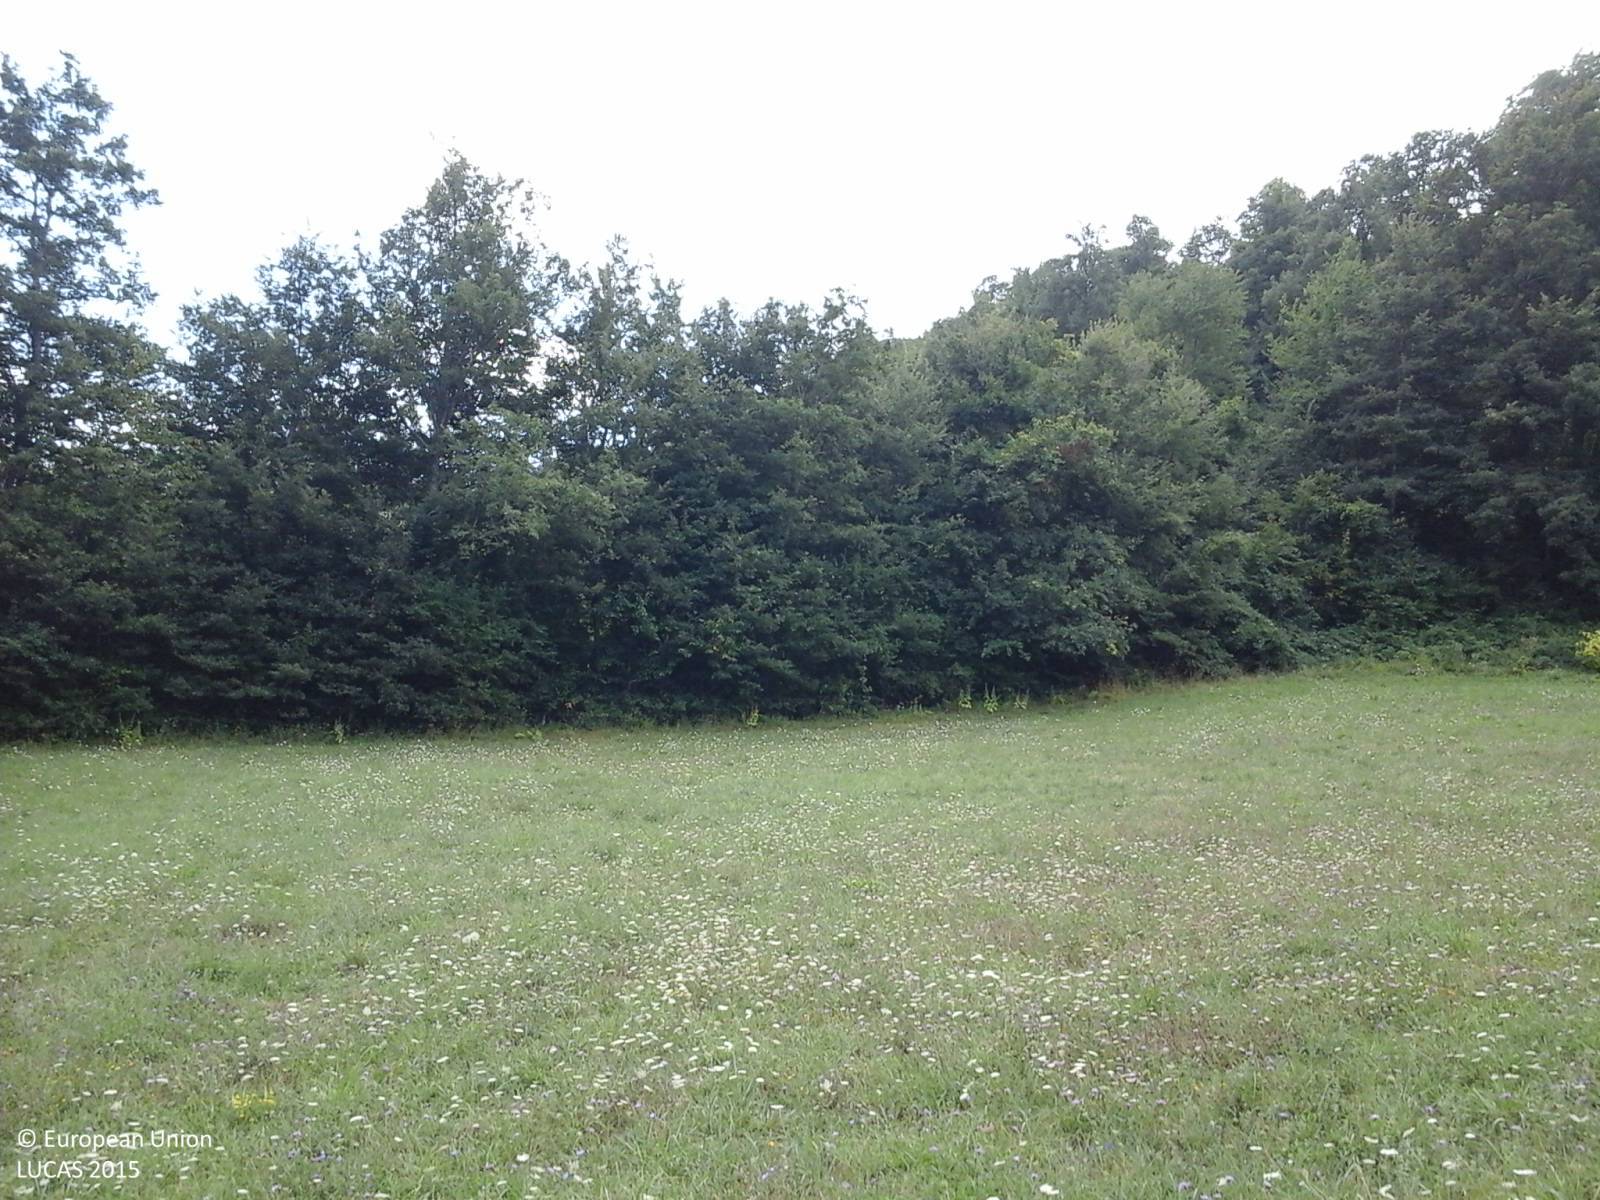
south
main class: Grassland
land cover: Grassland without tree/shrub cover
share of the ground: > 75 %
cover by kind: herbaceous plants 100 %
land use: Agriculture (excluding fallow land and kitchen gardens)
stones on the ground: < 10 %
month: August
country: IT
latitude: 43.7154
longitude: 12.1170
